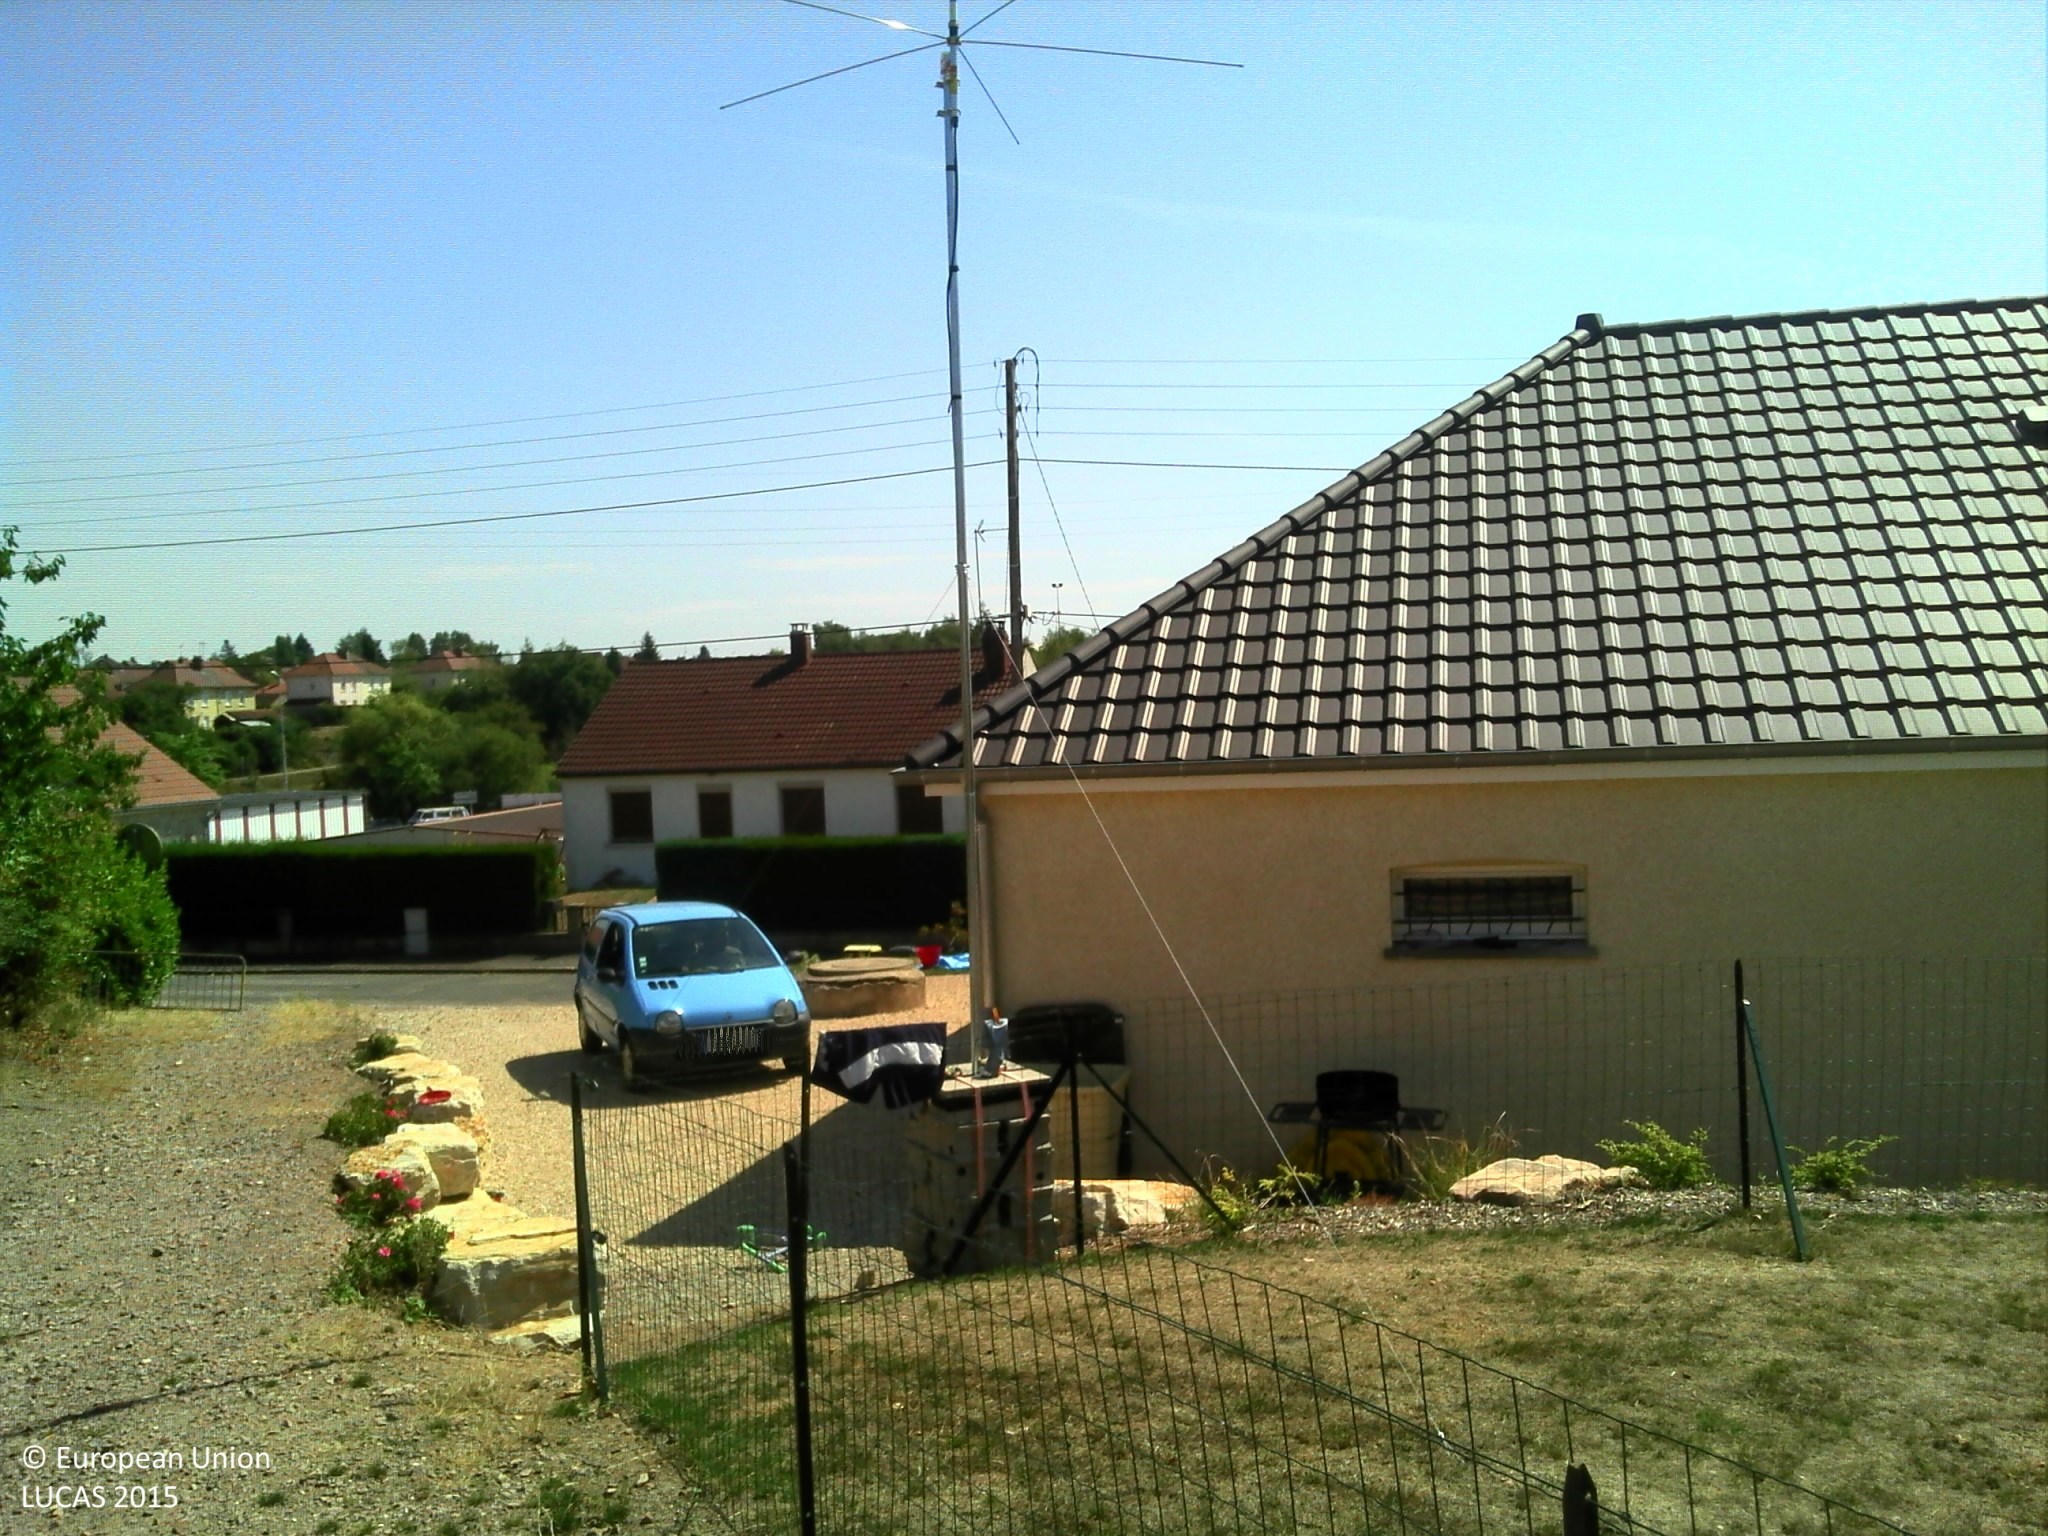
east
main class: Grassland
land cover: Grassland with sparse tree/shrub cover
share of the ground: > 75 %
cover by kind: herbaceous plants 95 %, broadleaved forest trees 5 %
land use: Residential
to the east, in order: Grassland with sparse tree/shrub cover; Artificial constructions in urban areas; Broadleaved woodland; Electric lines; Broadleaved woodland; Fences; Tracks
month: August
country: FR
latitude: 46.8032
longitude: 4.4579
